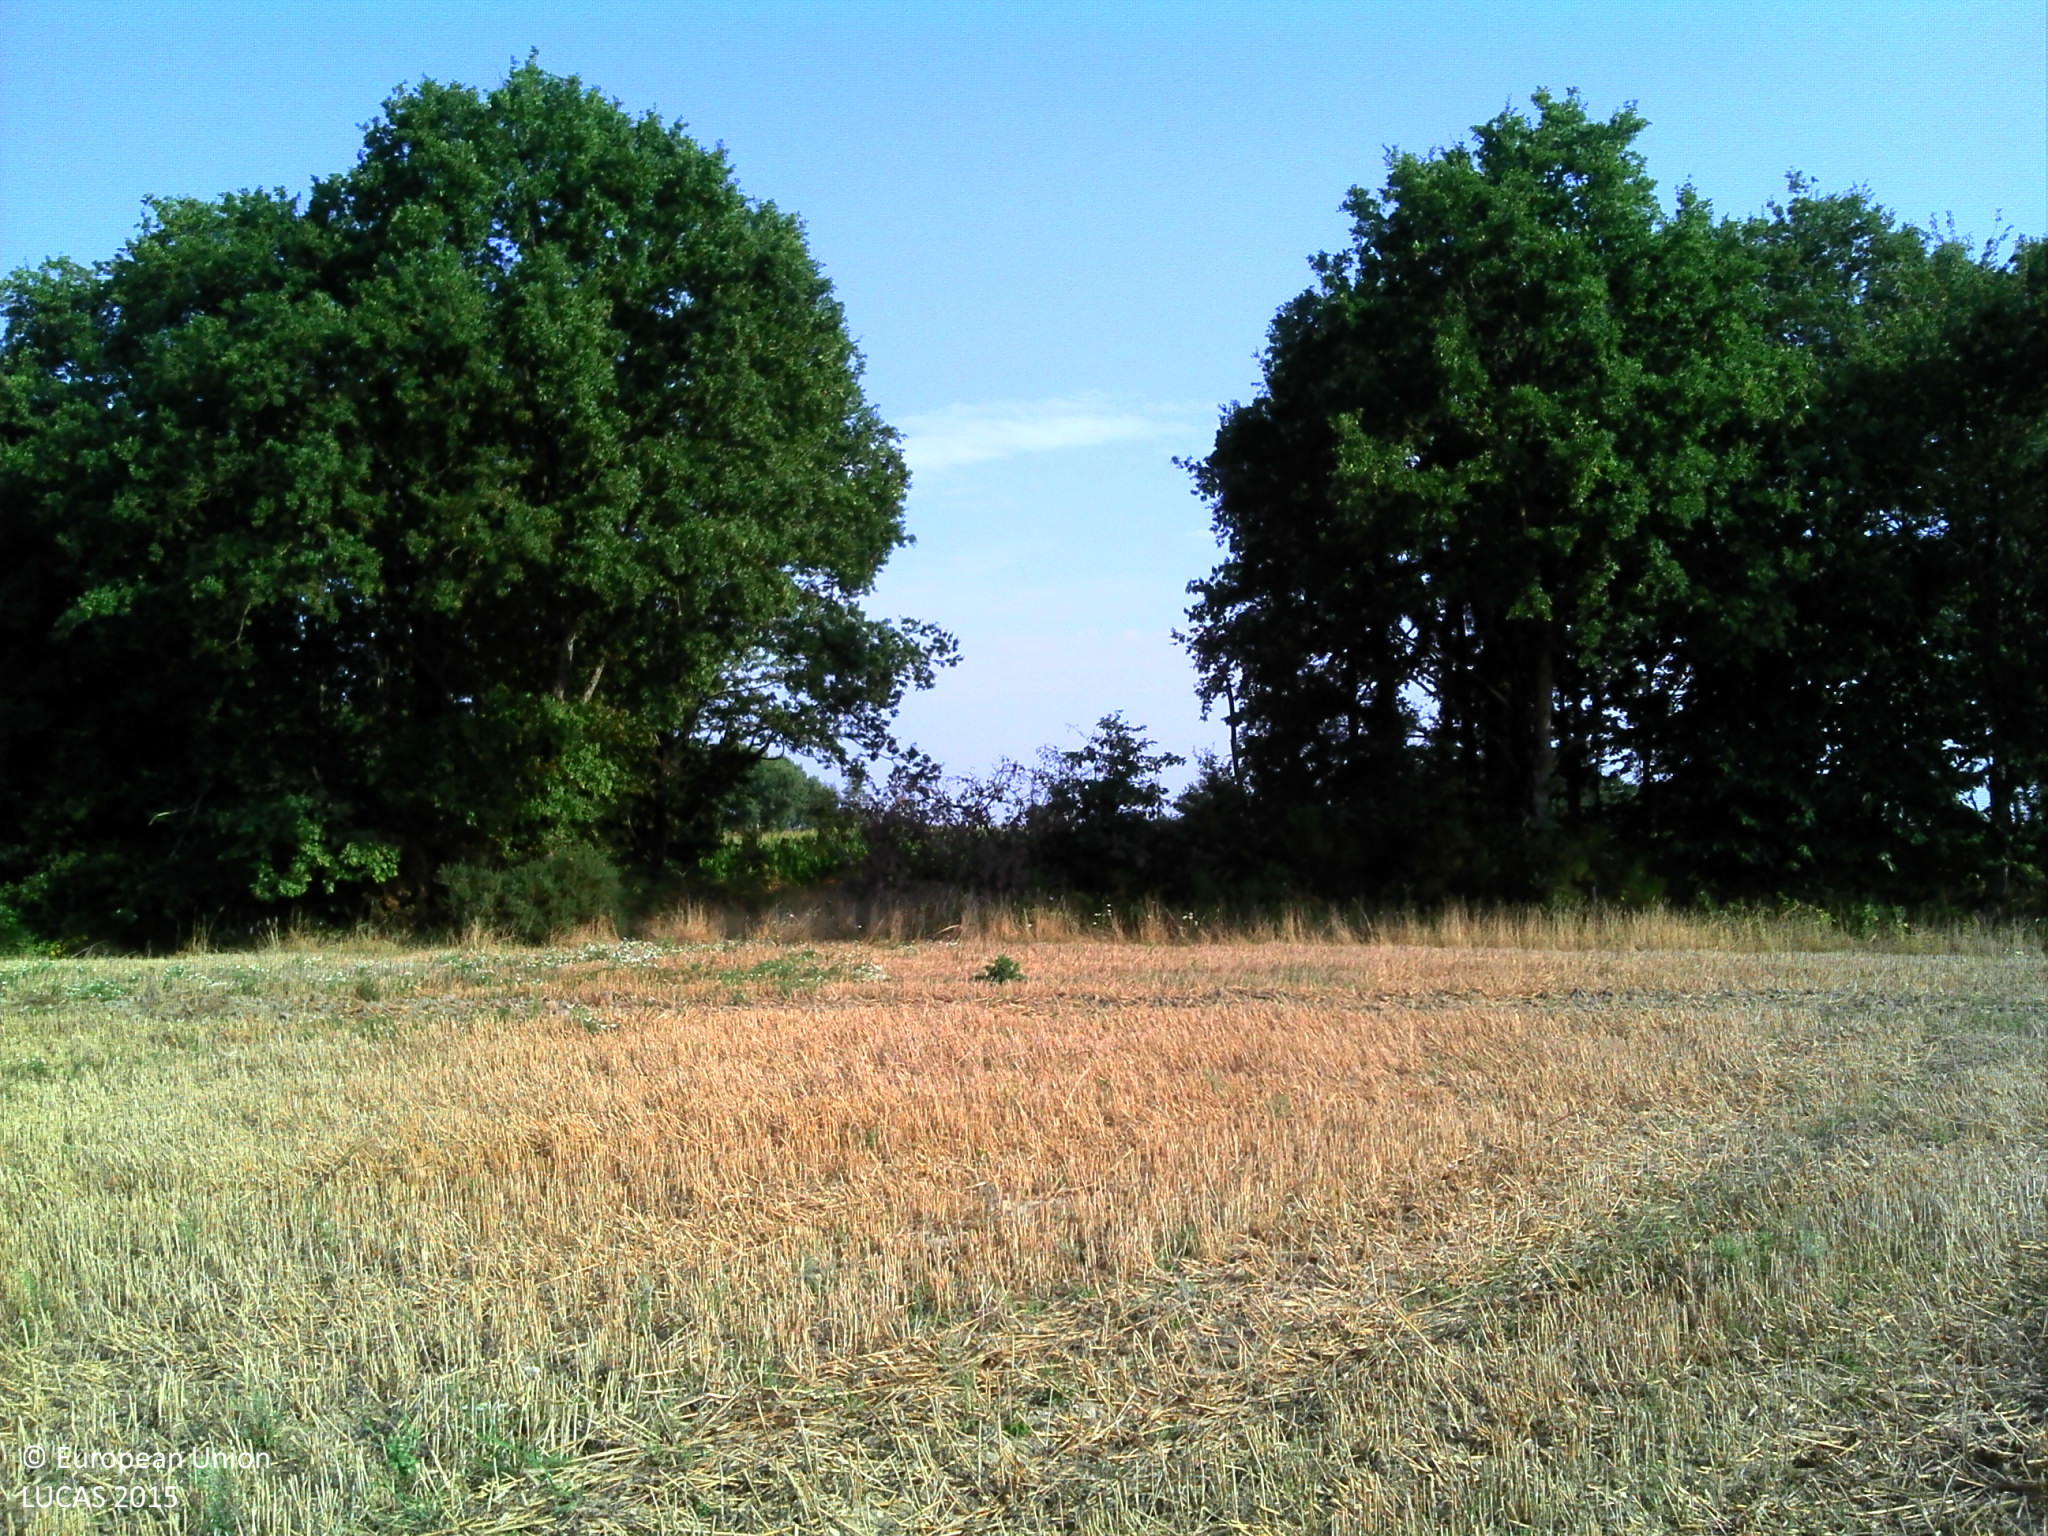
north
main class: Cropland
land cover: Triticale
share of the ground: > 75 %
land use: Agriculture (excluding fallow land and kitchen gardens)
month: August
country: FR
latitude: 46.9468
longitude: -1.6695
